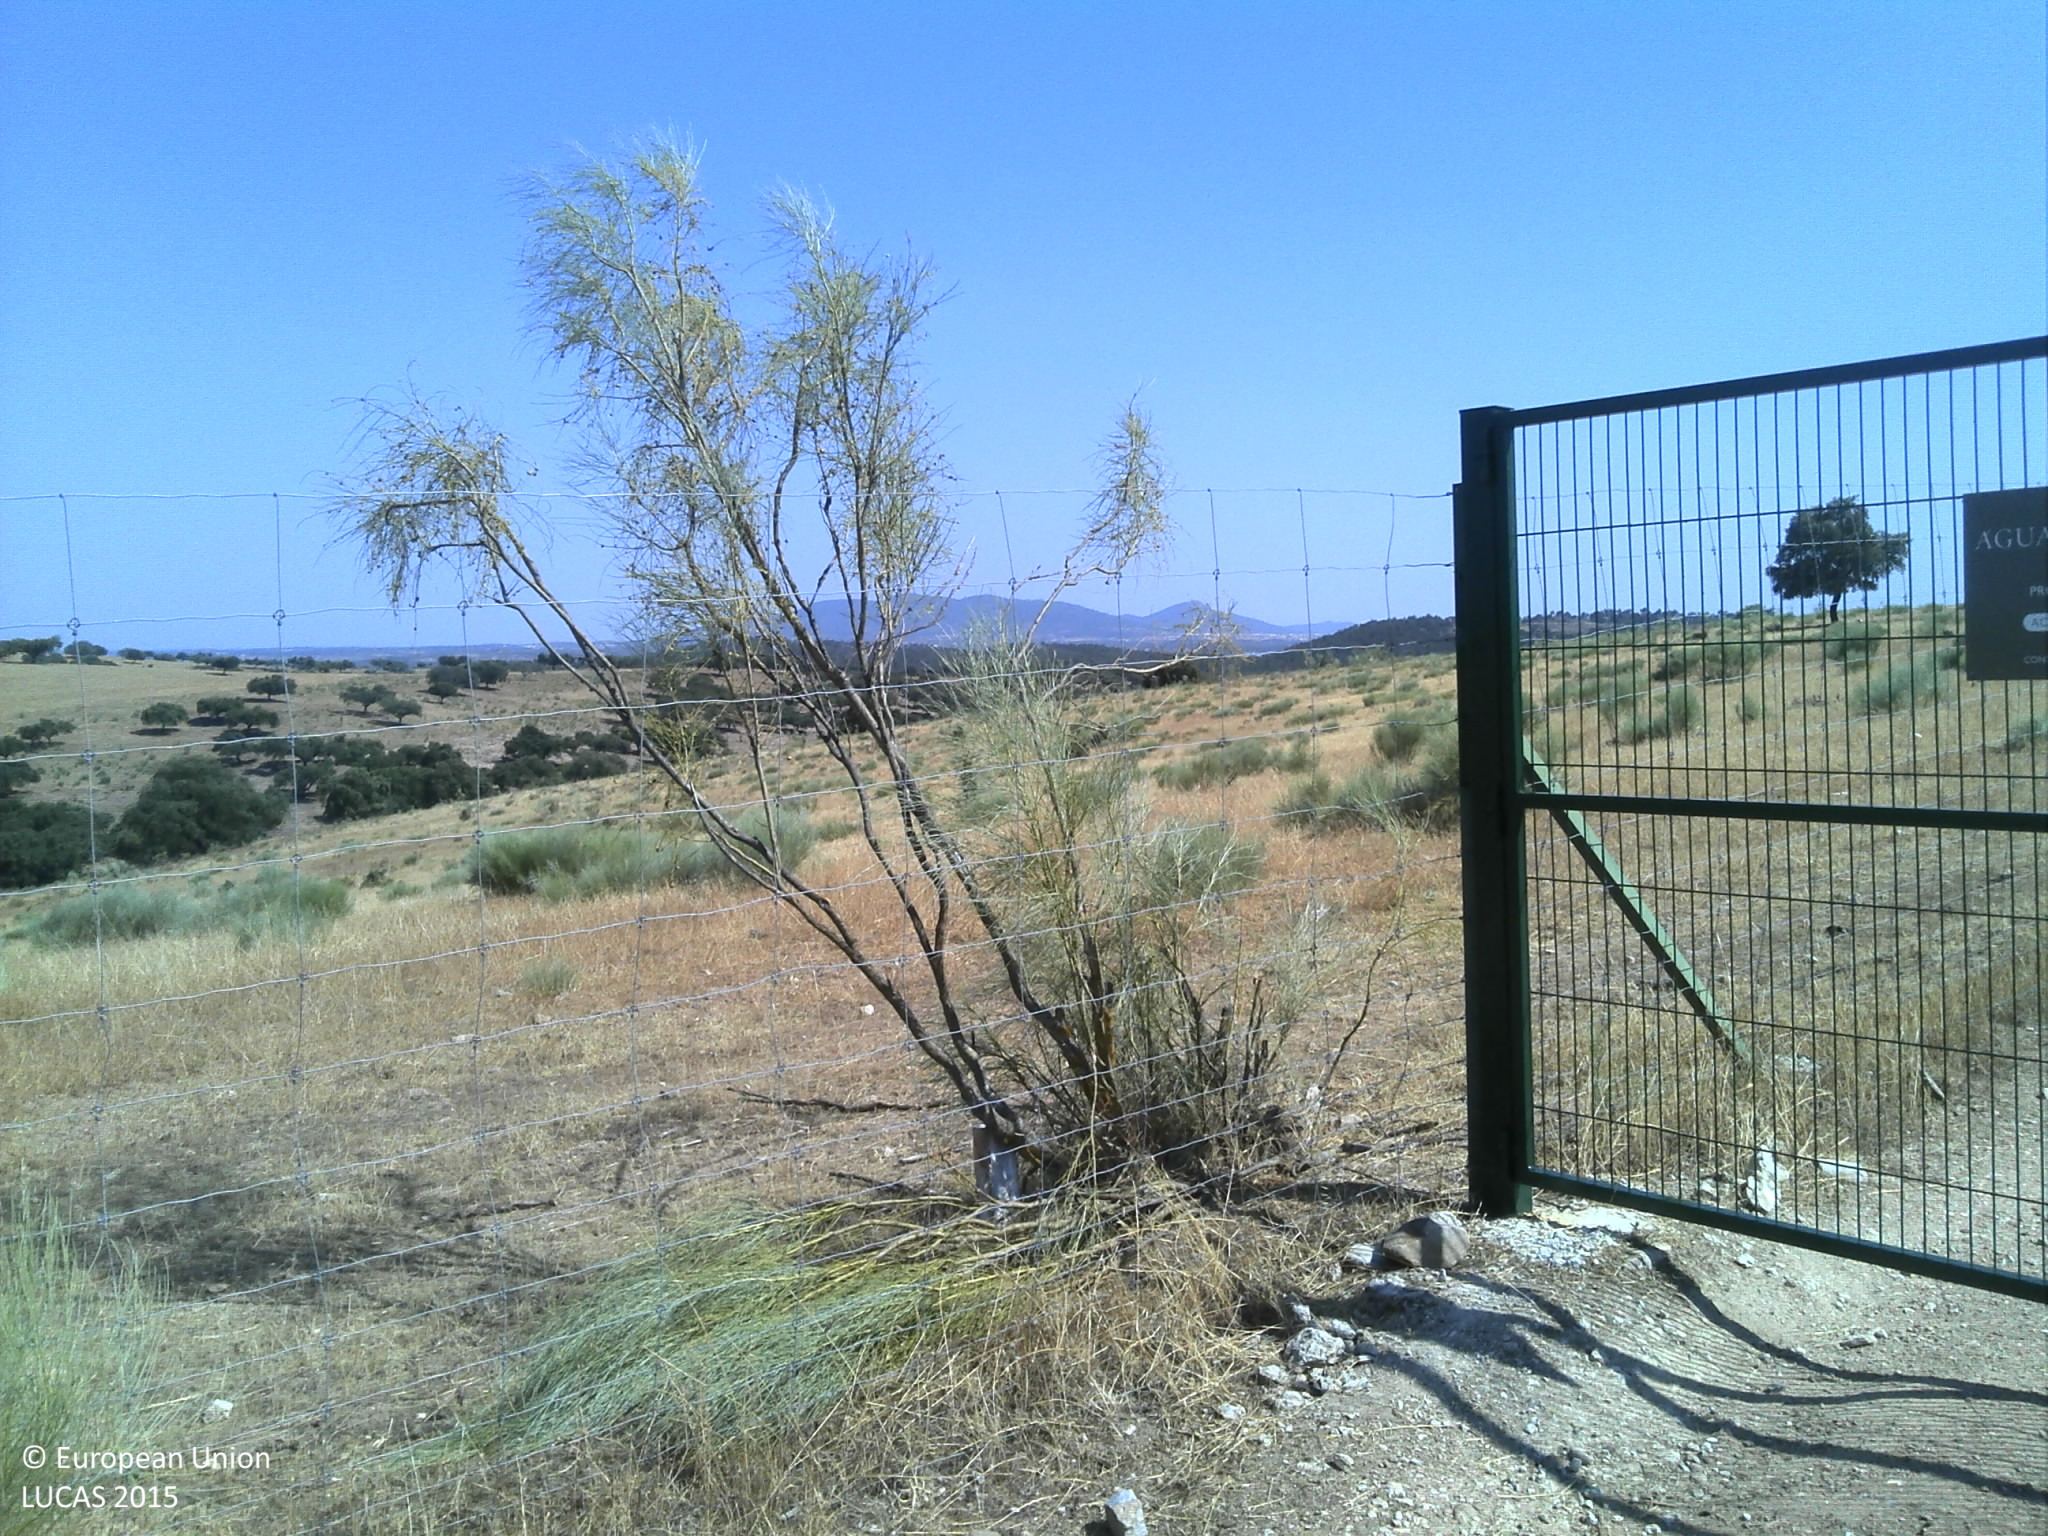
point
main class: Woodland
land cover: Broadleaved woodland
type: broadleaved evergreen forest
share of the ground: 25 - 50 %
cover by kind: herbaceous plants 70 %, broadleaved forest trees 30 %
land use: Forestry
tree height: > 5 m
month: June
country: PT
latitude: 39.6789
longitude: -7.2884
